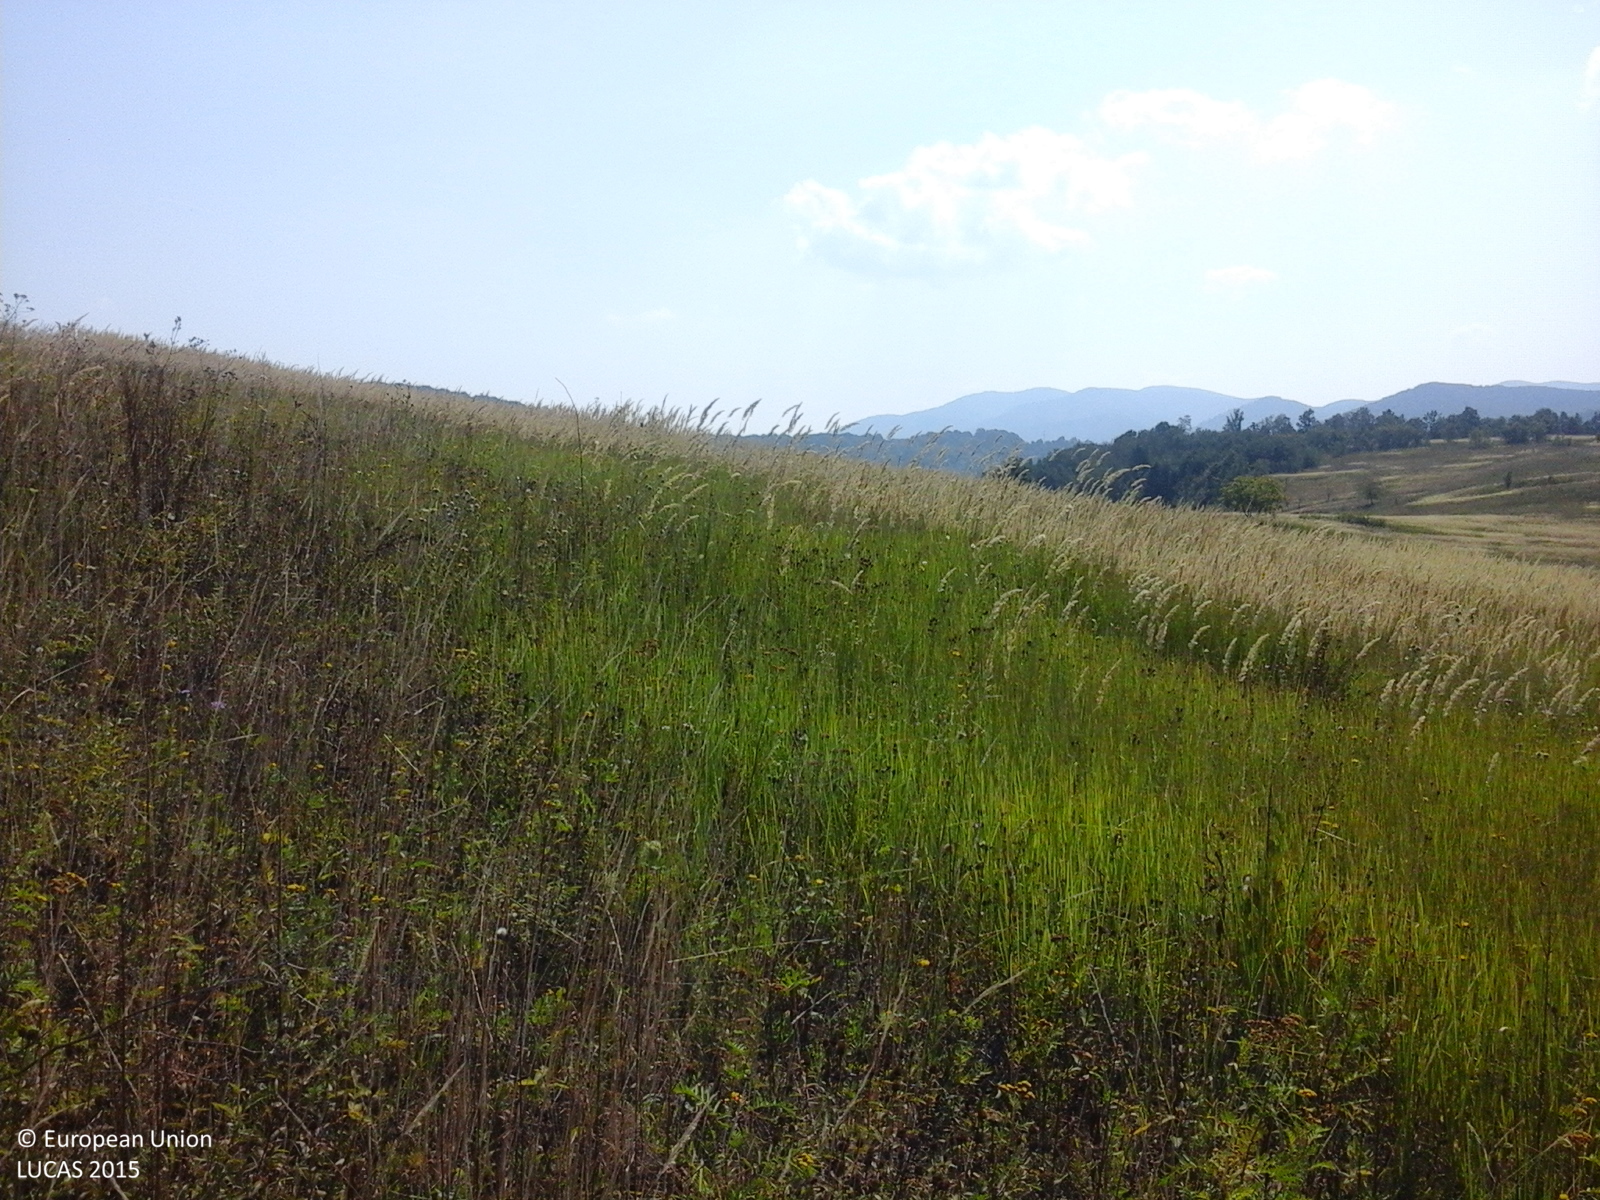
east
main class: Grassland
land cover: Grassland without tree/shrub cover
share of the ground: > 75 %
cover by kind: herbaceous plants 100 %
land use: Agriculture (excluding fallow land and kitchen gardens)
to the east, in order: Grassland without tree/shrub cover; Tracks; Grassland with sparse tree/shrub cover; Lines of trees; Grassland with sparse tree/shrub cover; Lines of trees; Grassland with sparse tree/shrub cover
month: August
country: RO
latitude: 46.3069
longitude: 22.3443
